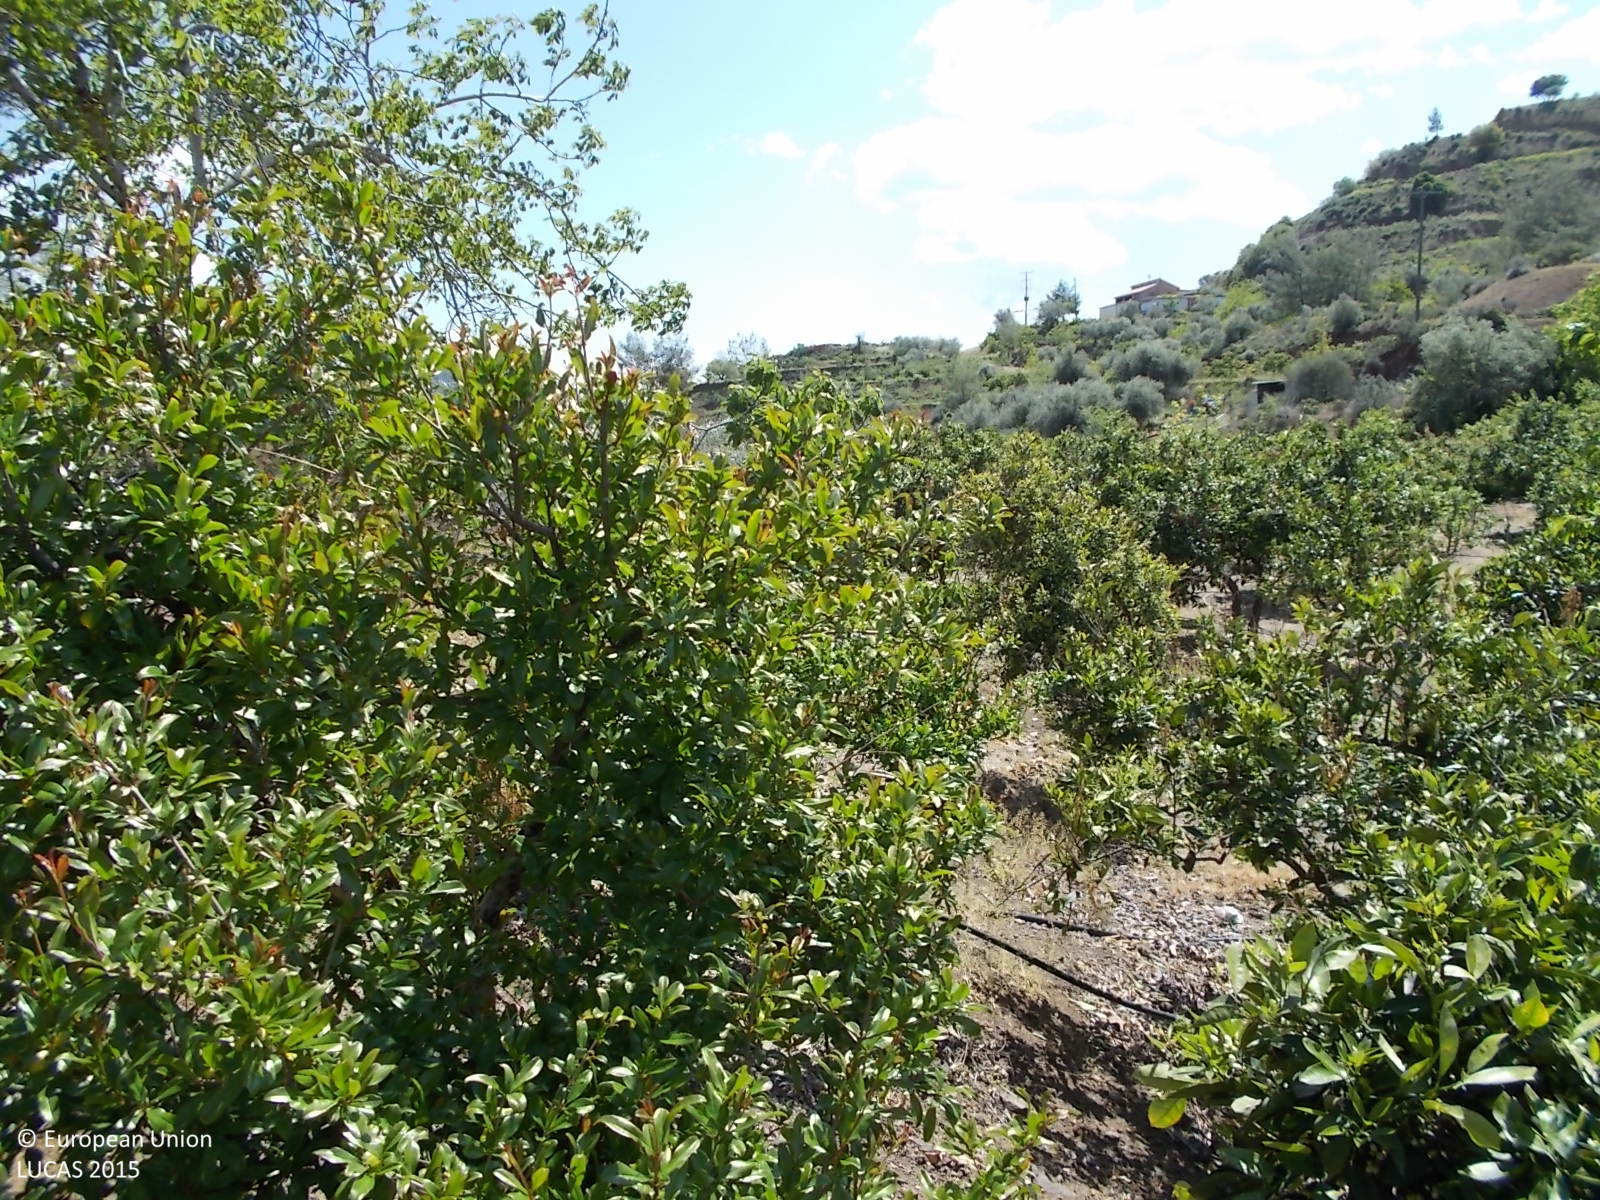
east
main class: Cropland
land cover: Other citrus fruit
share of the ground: > 75 %
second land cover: Other bare soil
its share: > 75 %
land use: Agriculture (excluding fallow land and kitchen gardens)
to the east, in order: Other citrus fruit; Other bare soil; Grassland with sparse tree/shrub cover; Olive groves; Other citrus fruit; Paved roads, cycling and walking lanes; Other citrus fruit; Grassland without tree/shrub cover; Shrubland without tree cover; Paved roads, cycling and walking lanes; Other citrus fruit
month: April
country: CY
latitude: 34.8475
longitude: 33.0840
